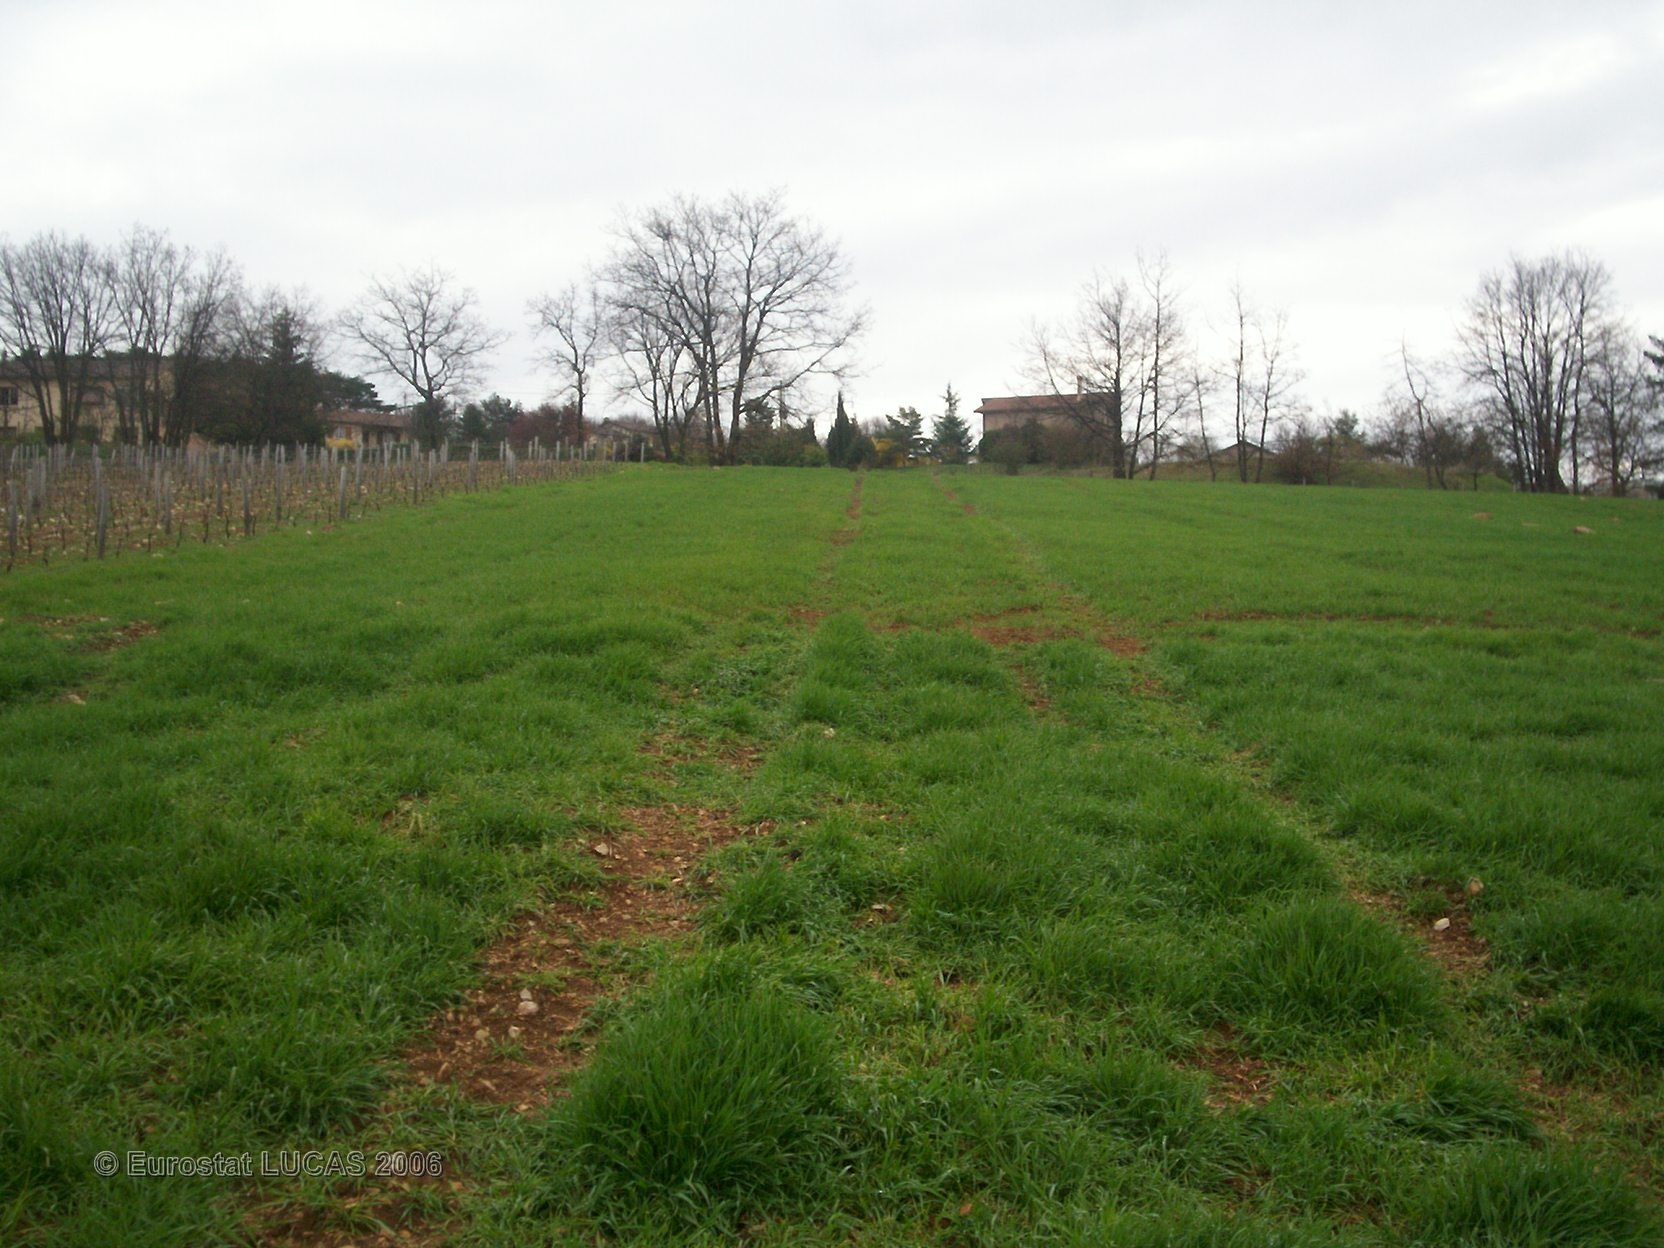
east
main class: Cropland
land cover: Barley
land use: Agriculture (excluding fallow land and kitchen gardens)
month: April
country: FR
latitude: 46.3494
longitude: 4.7653
